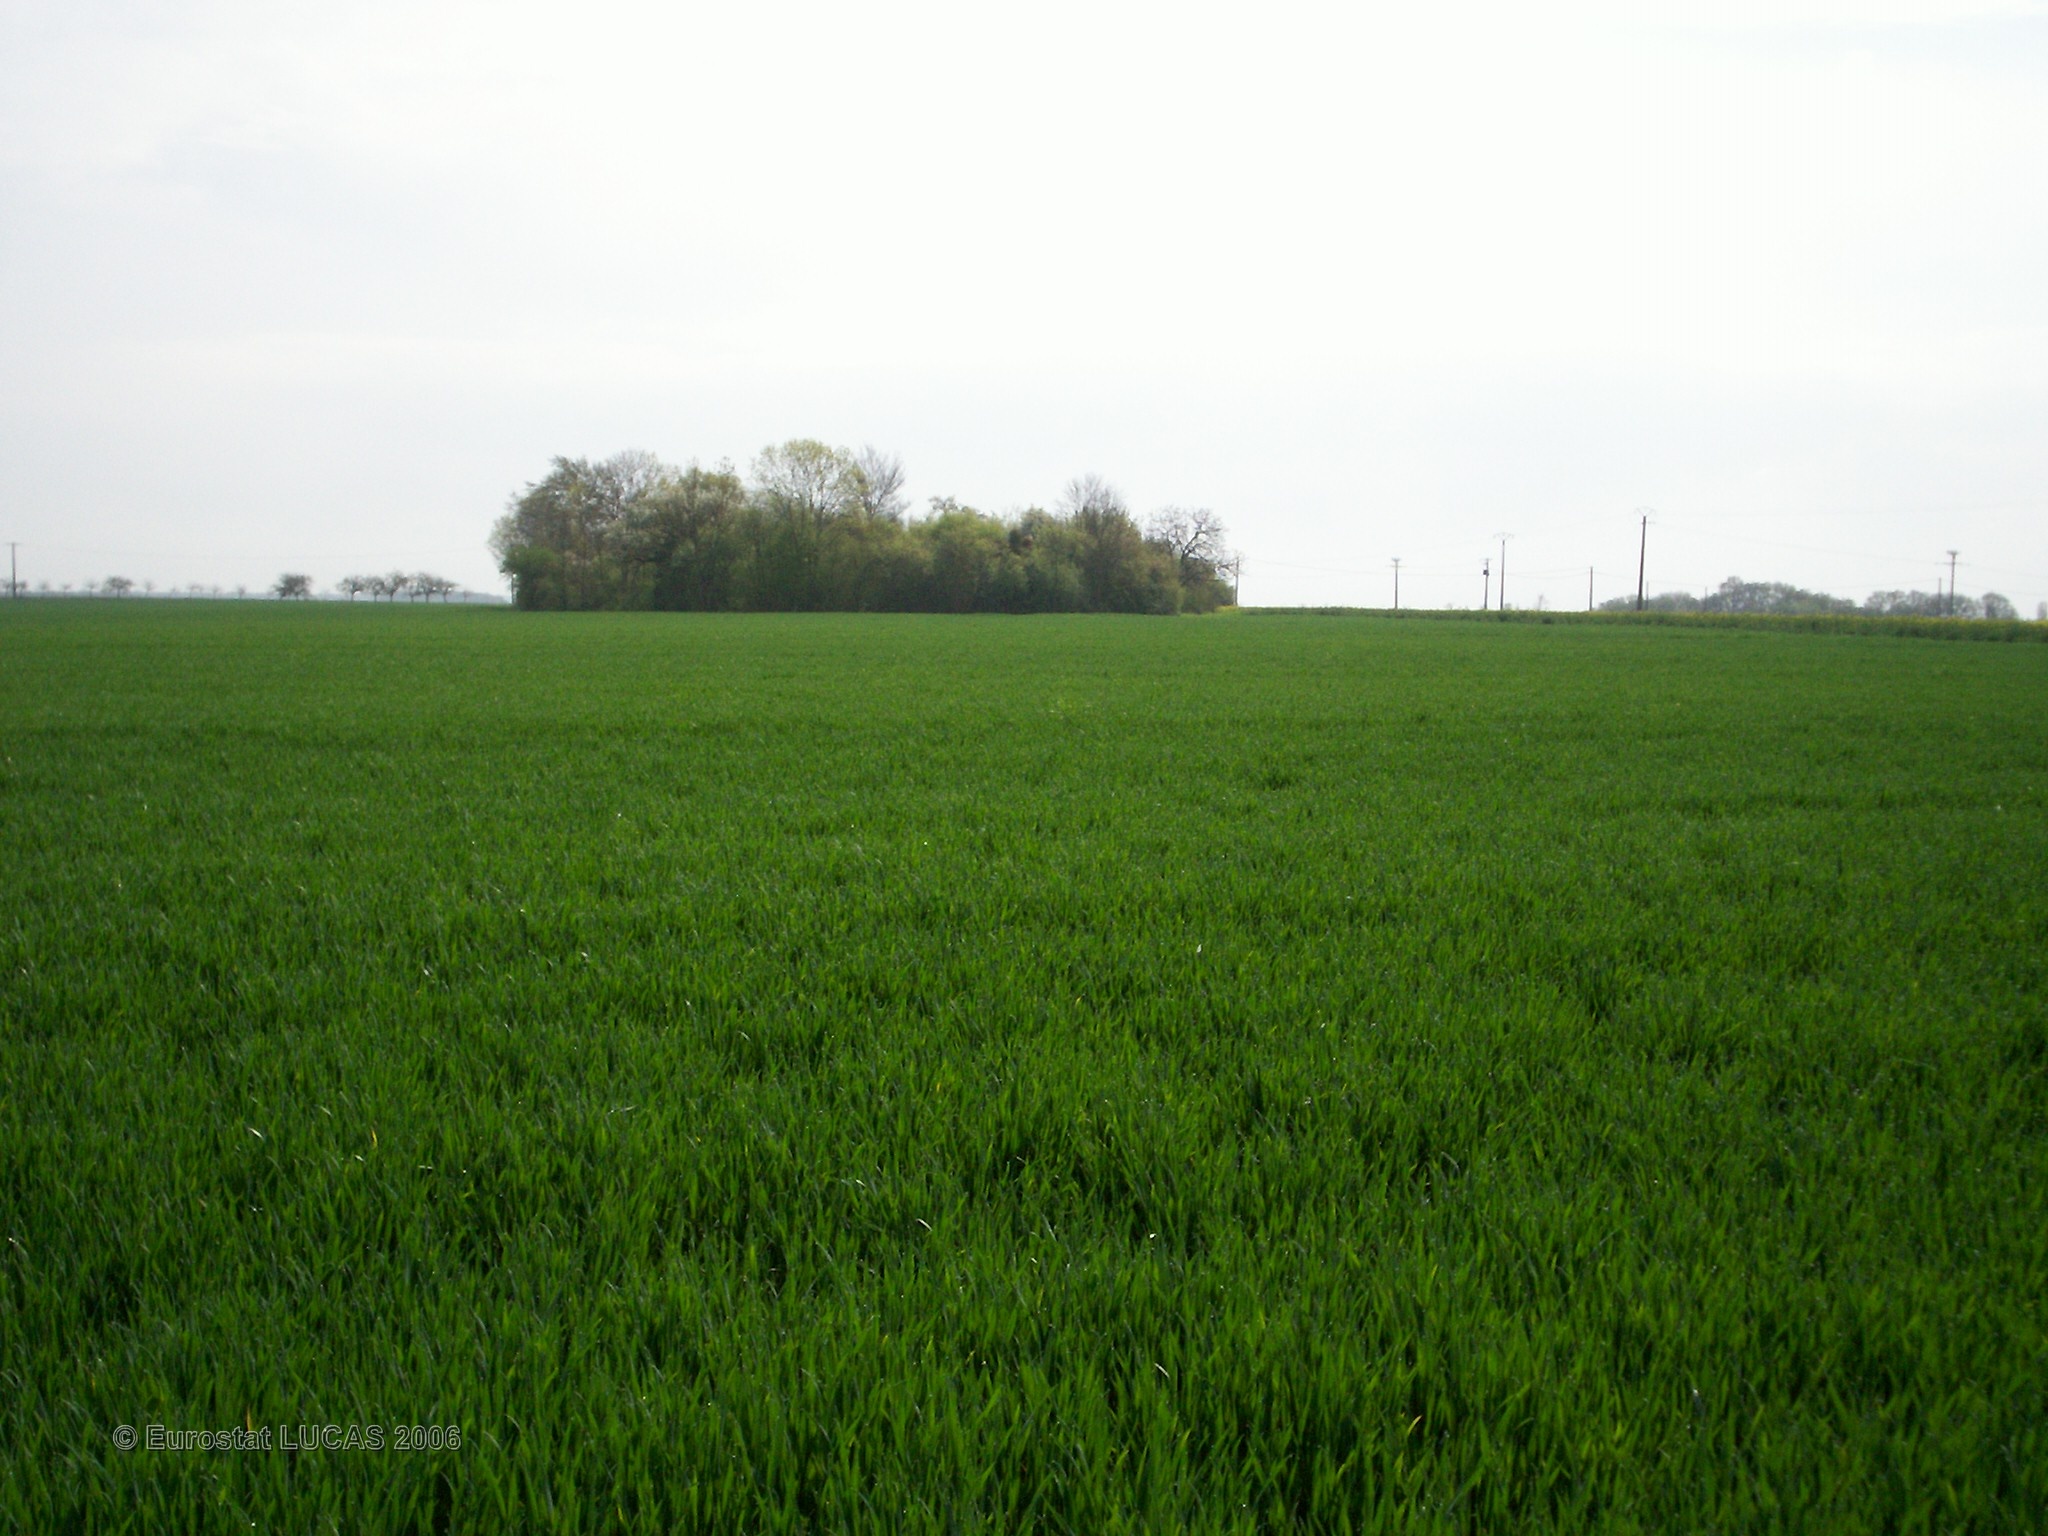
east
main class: Cropland
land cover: Common wheat
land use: Agriculture (excluding fallow land and kitchen gardens)
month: April
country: FR
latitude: 47.8532
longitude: 2.9498
